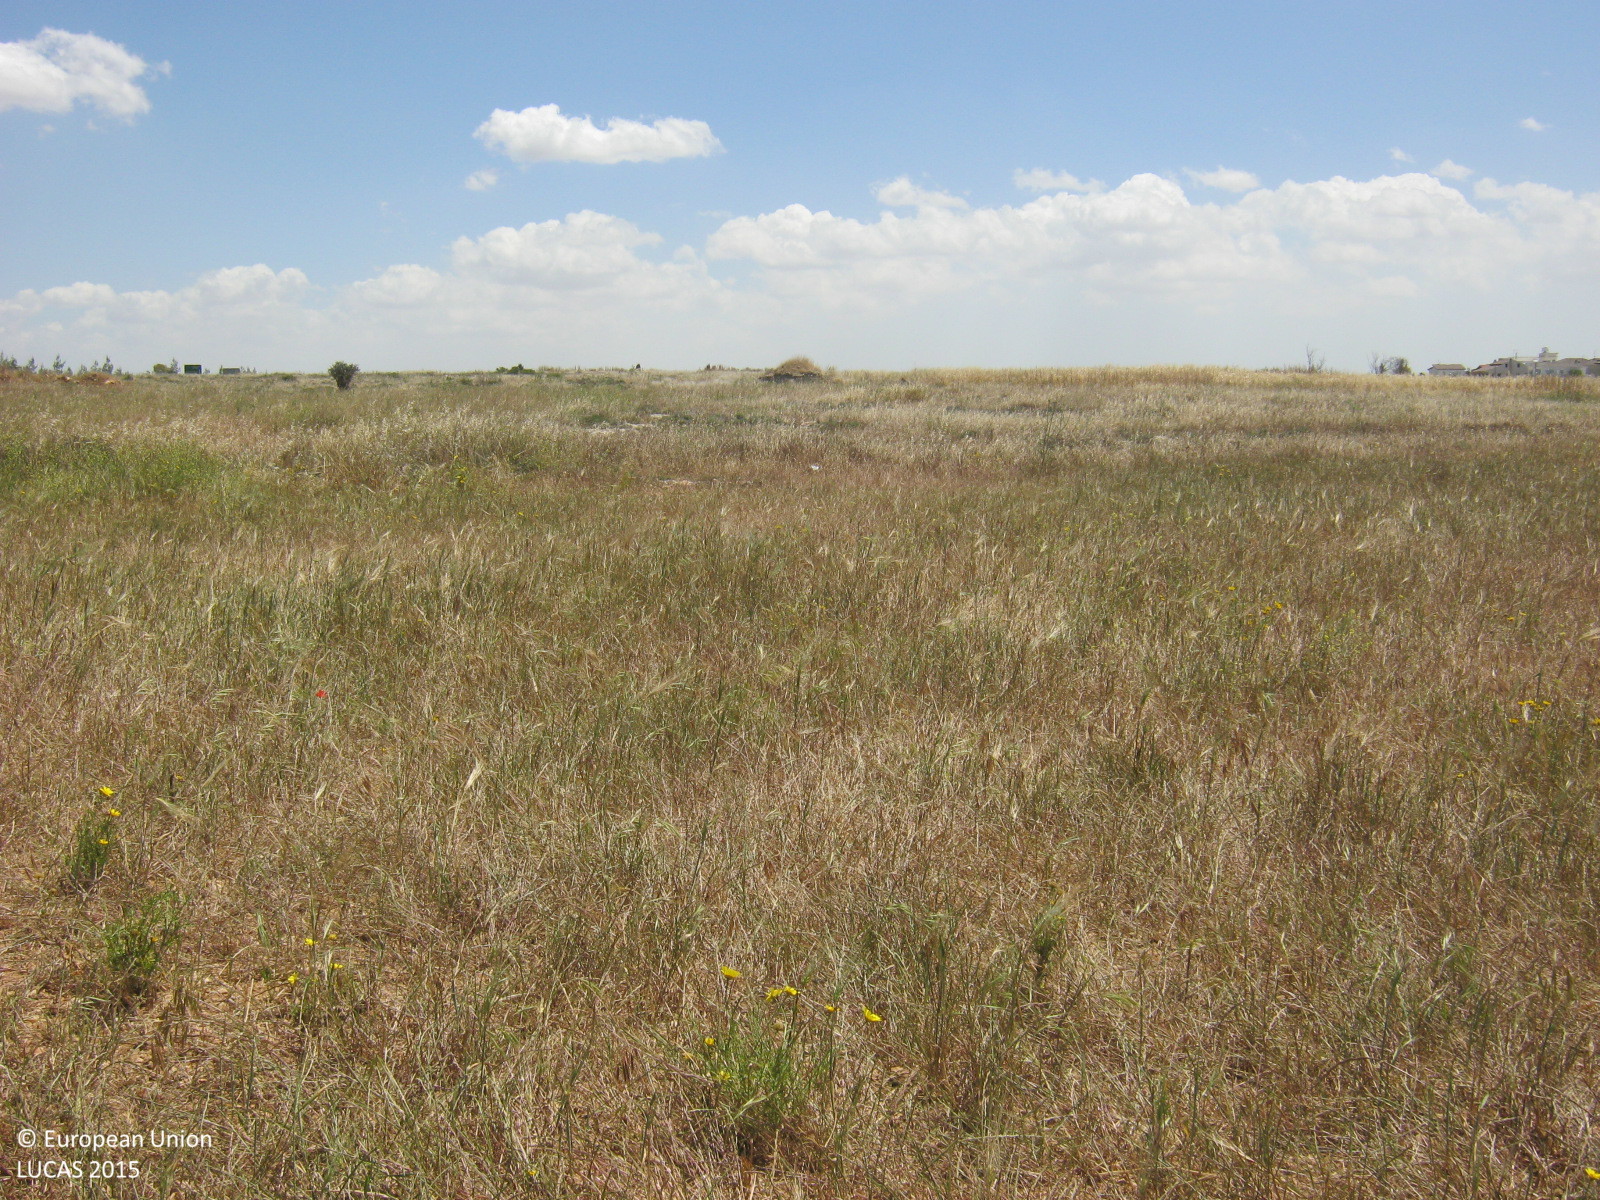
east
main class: Grassland
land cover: Spontaneously vegetated surfaces
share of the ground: 50 - 75 %
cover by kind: herbaceous plants 65 %, unconsolidated bare surface 30 %, shrubs 5 %
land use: Agriculture (excluding fallow land and kitchen gardens)
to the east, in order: Spontaneously vegetated surfaces; Shrubland without tree cover
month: May
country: CY
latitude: 35.1591
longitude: 33.1855
